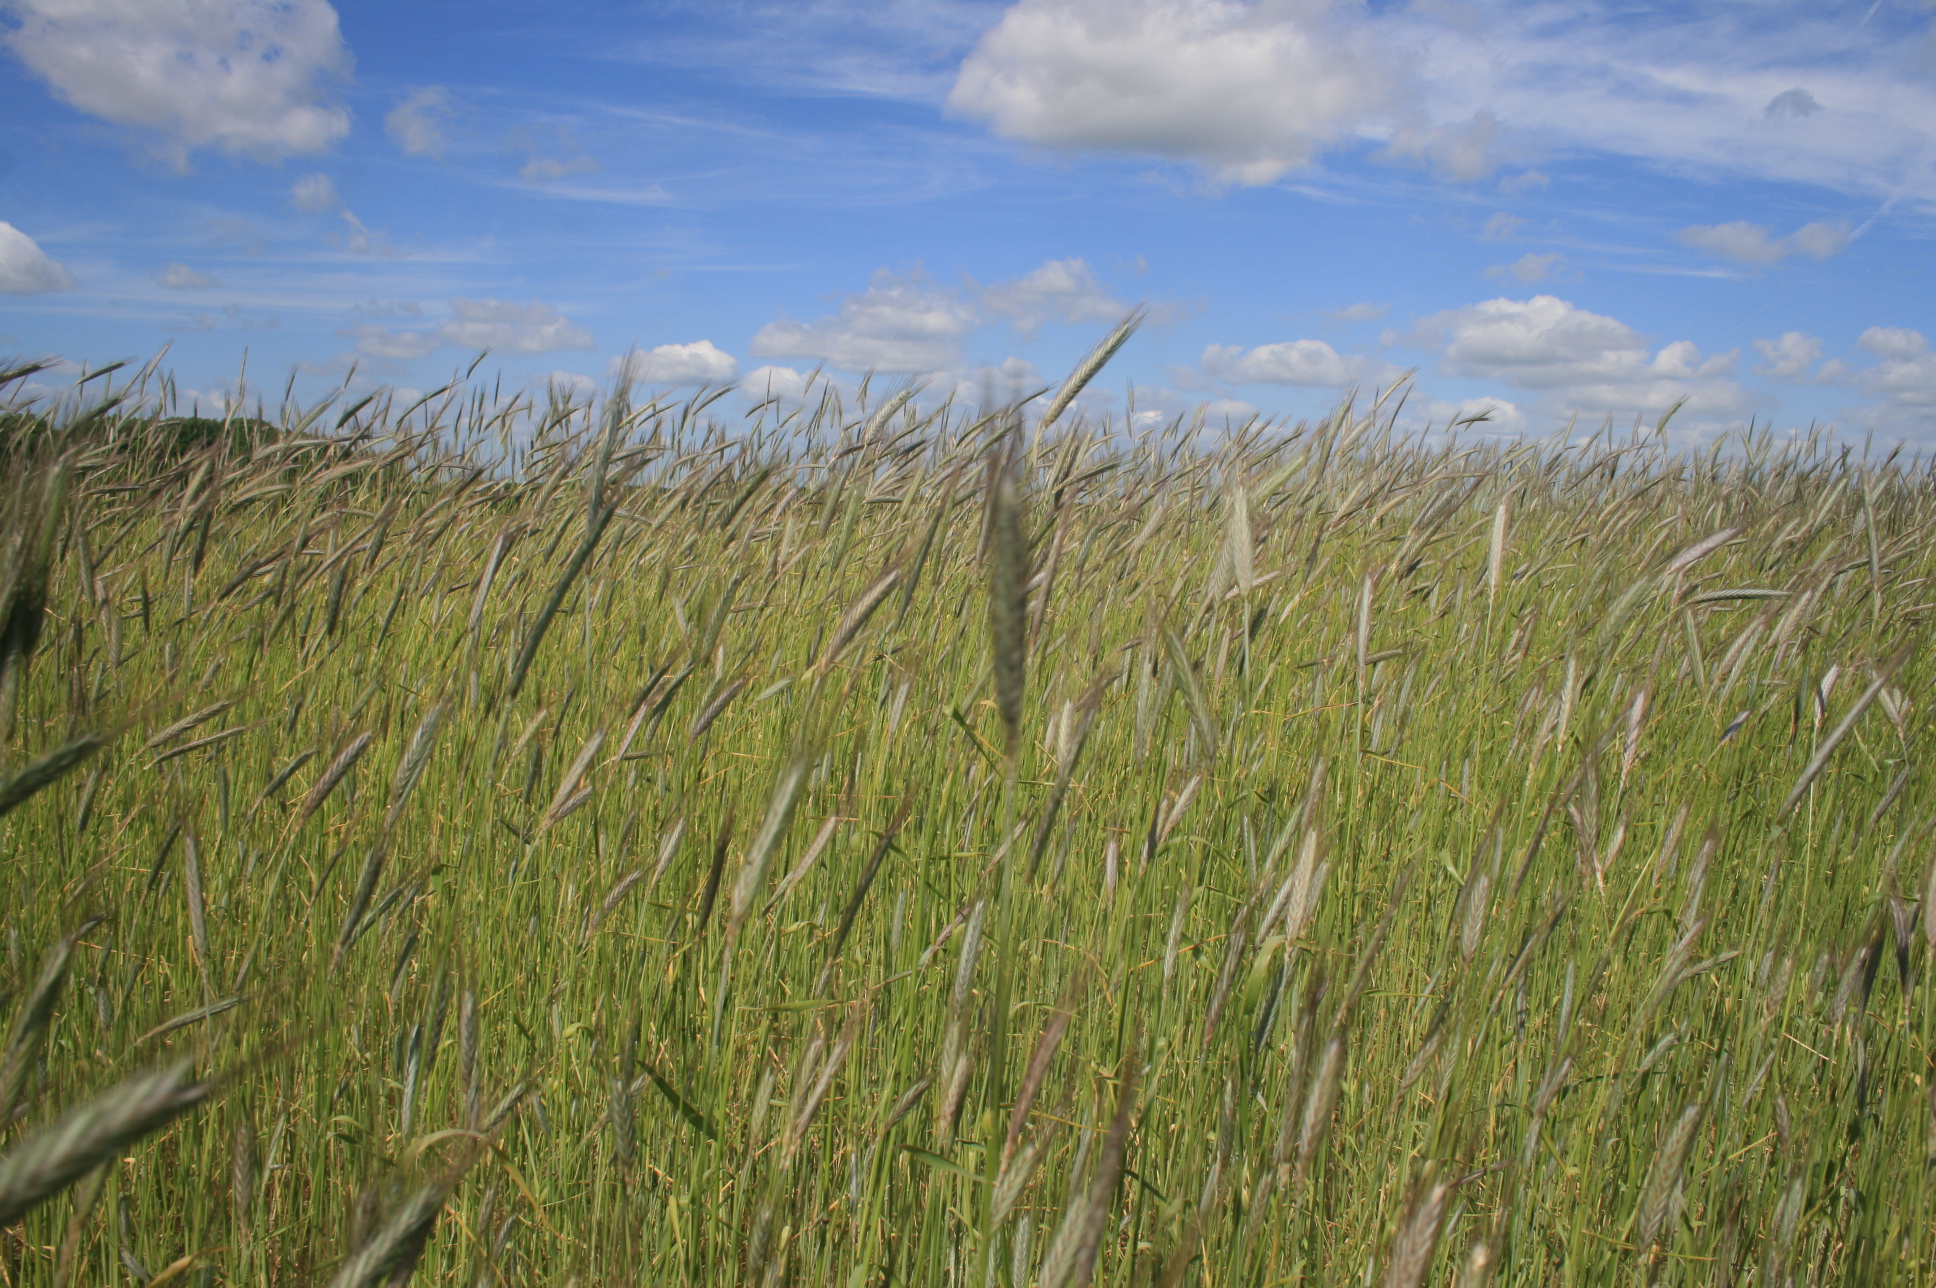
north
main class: Cropland
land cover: Rye
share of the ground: > 75 %
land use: Agriculture (excluding fallow land and kitchen gardens)
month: June
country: LT
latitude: 55.7561
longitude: 22.3106
